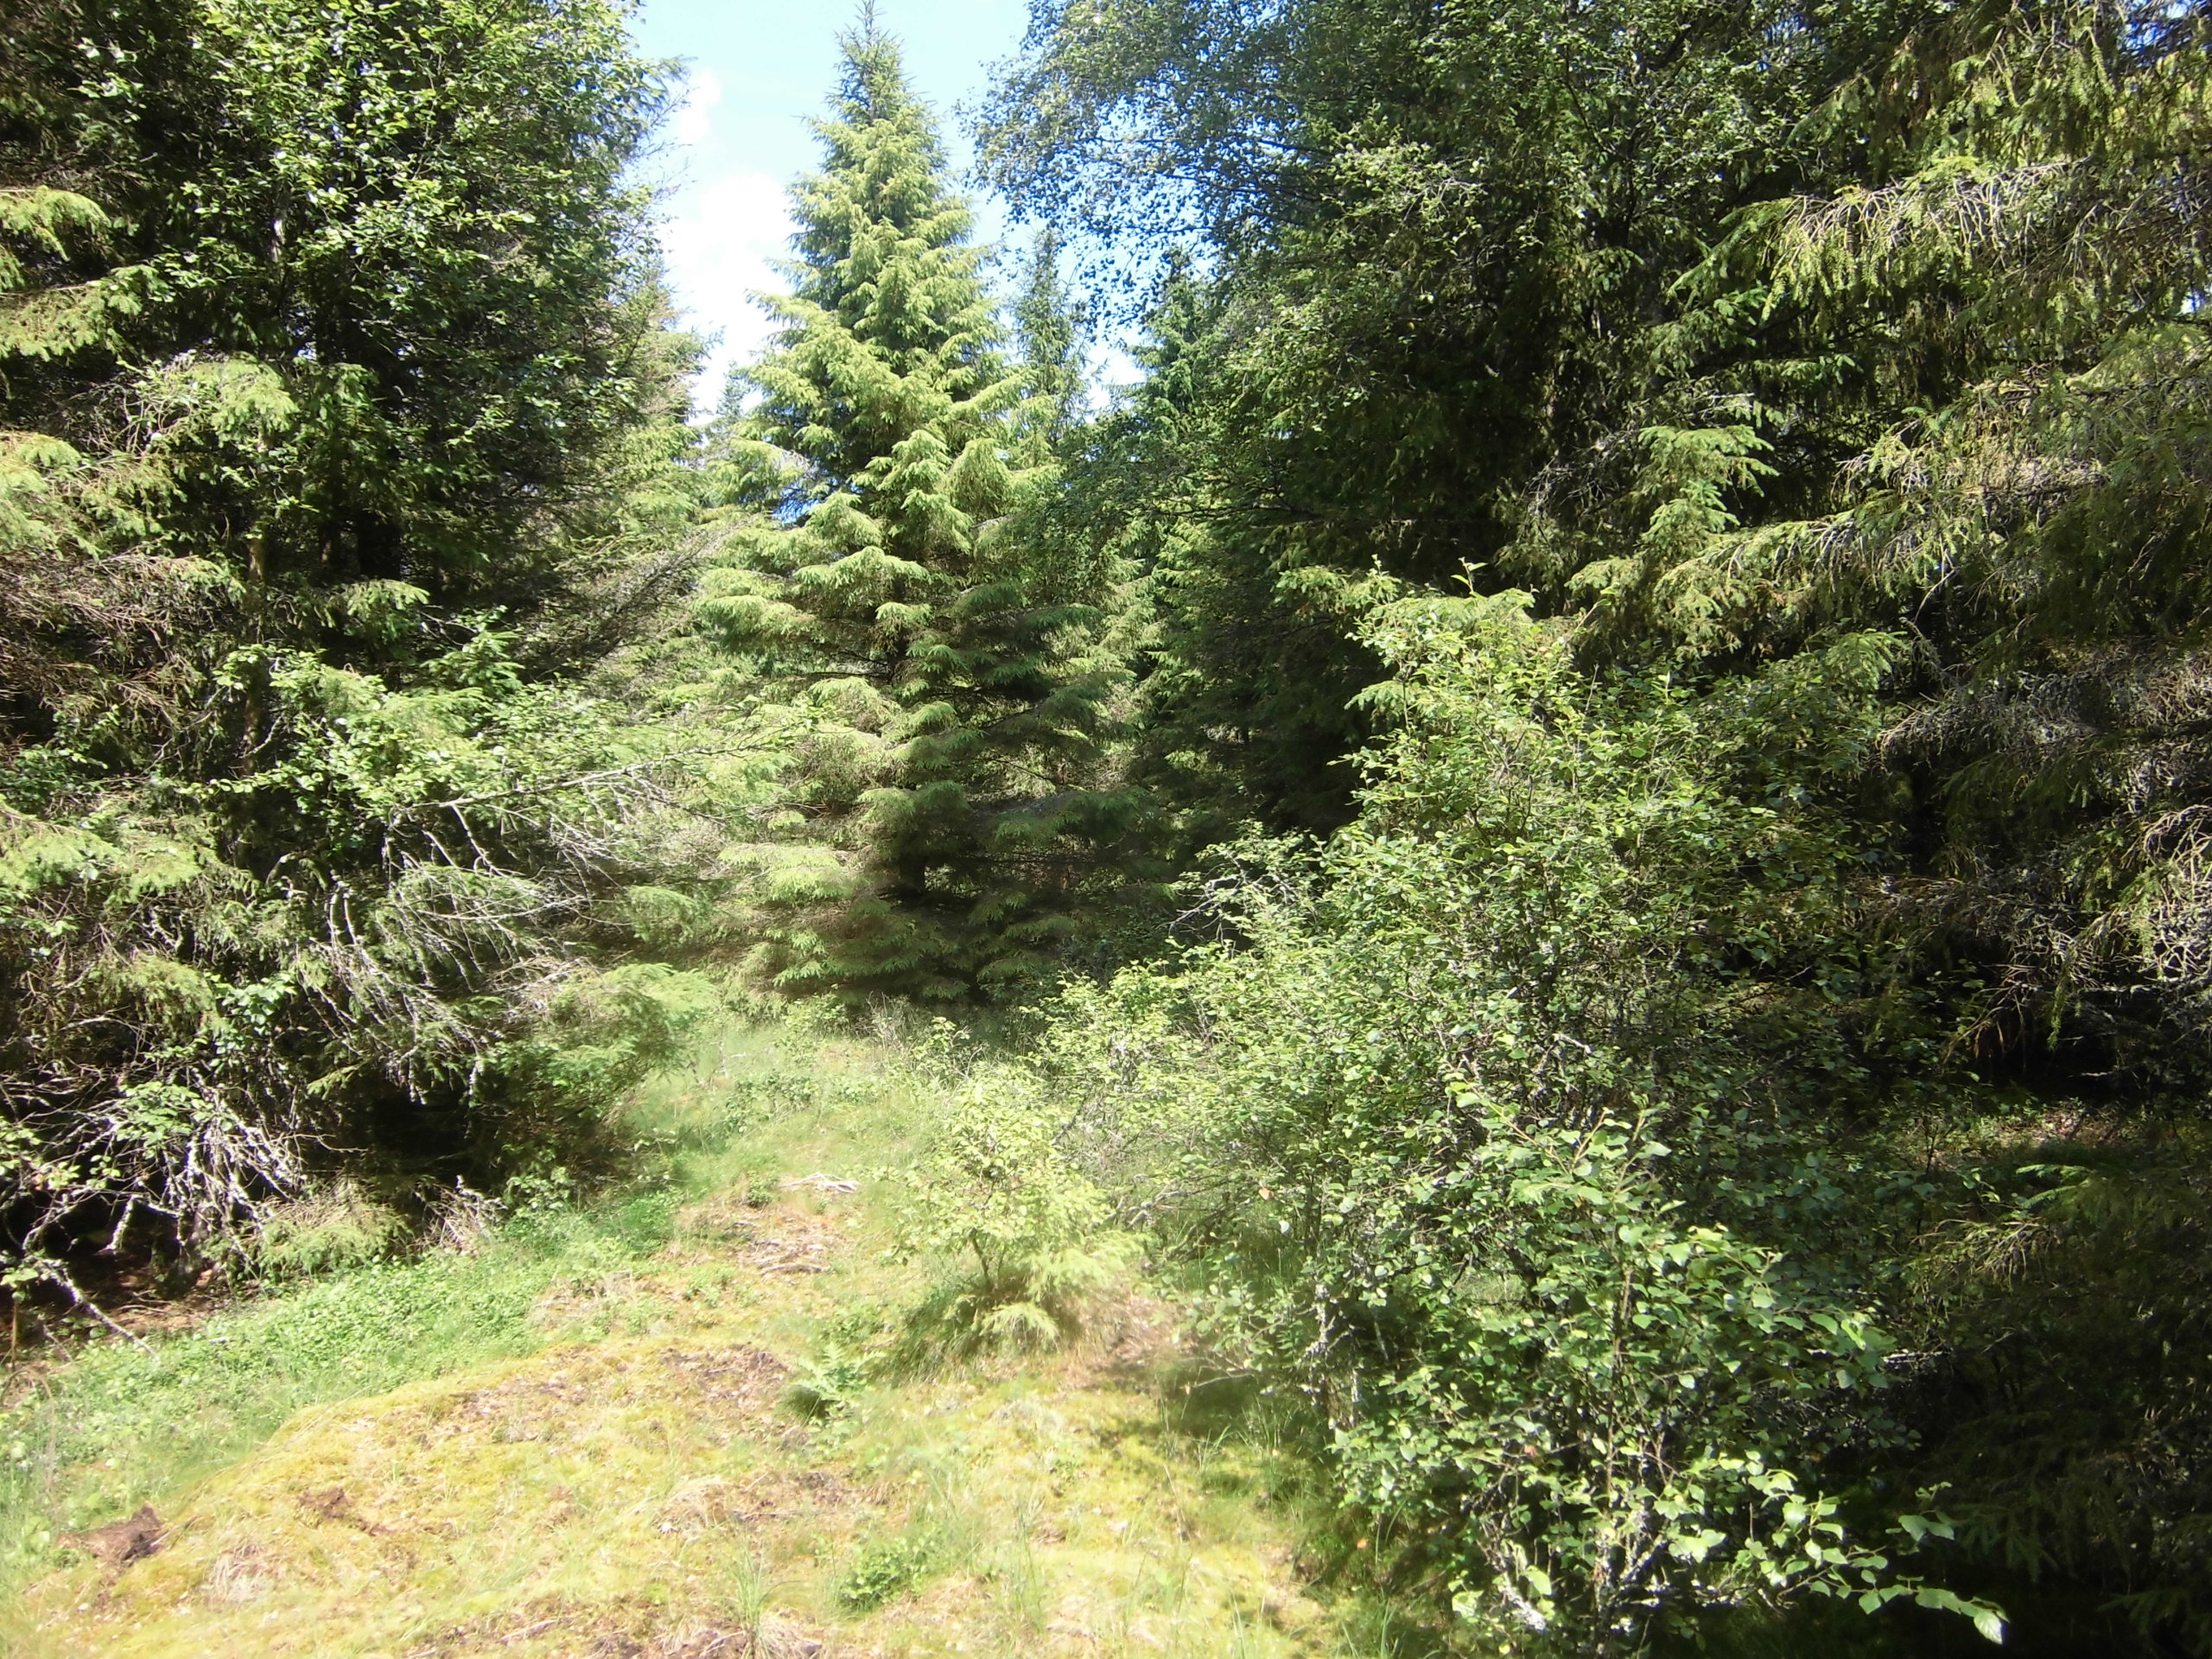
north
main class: Woodland
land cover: Spruce dominated coniferous woodland
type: boreal forest
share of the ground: 50 - 75 %
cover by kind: coniferous forest trees 50 %, shrubs 15 %, lichens and mosses 15 %, broadleaved forest trees 10 %, herbaceous plants 10 %
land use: Forestry
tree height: > 5 m
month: July
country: SE
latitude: 57.1541
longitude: 15.4362
